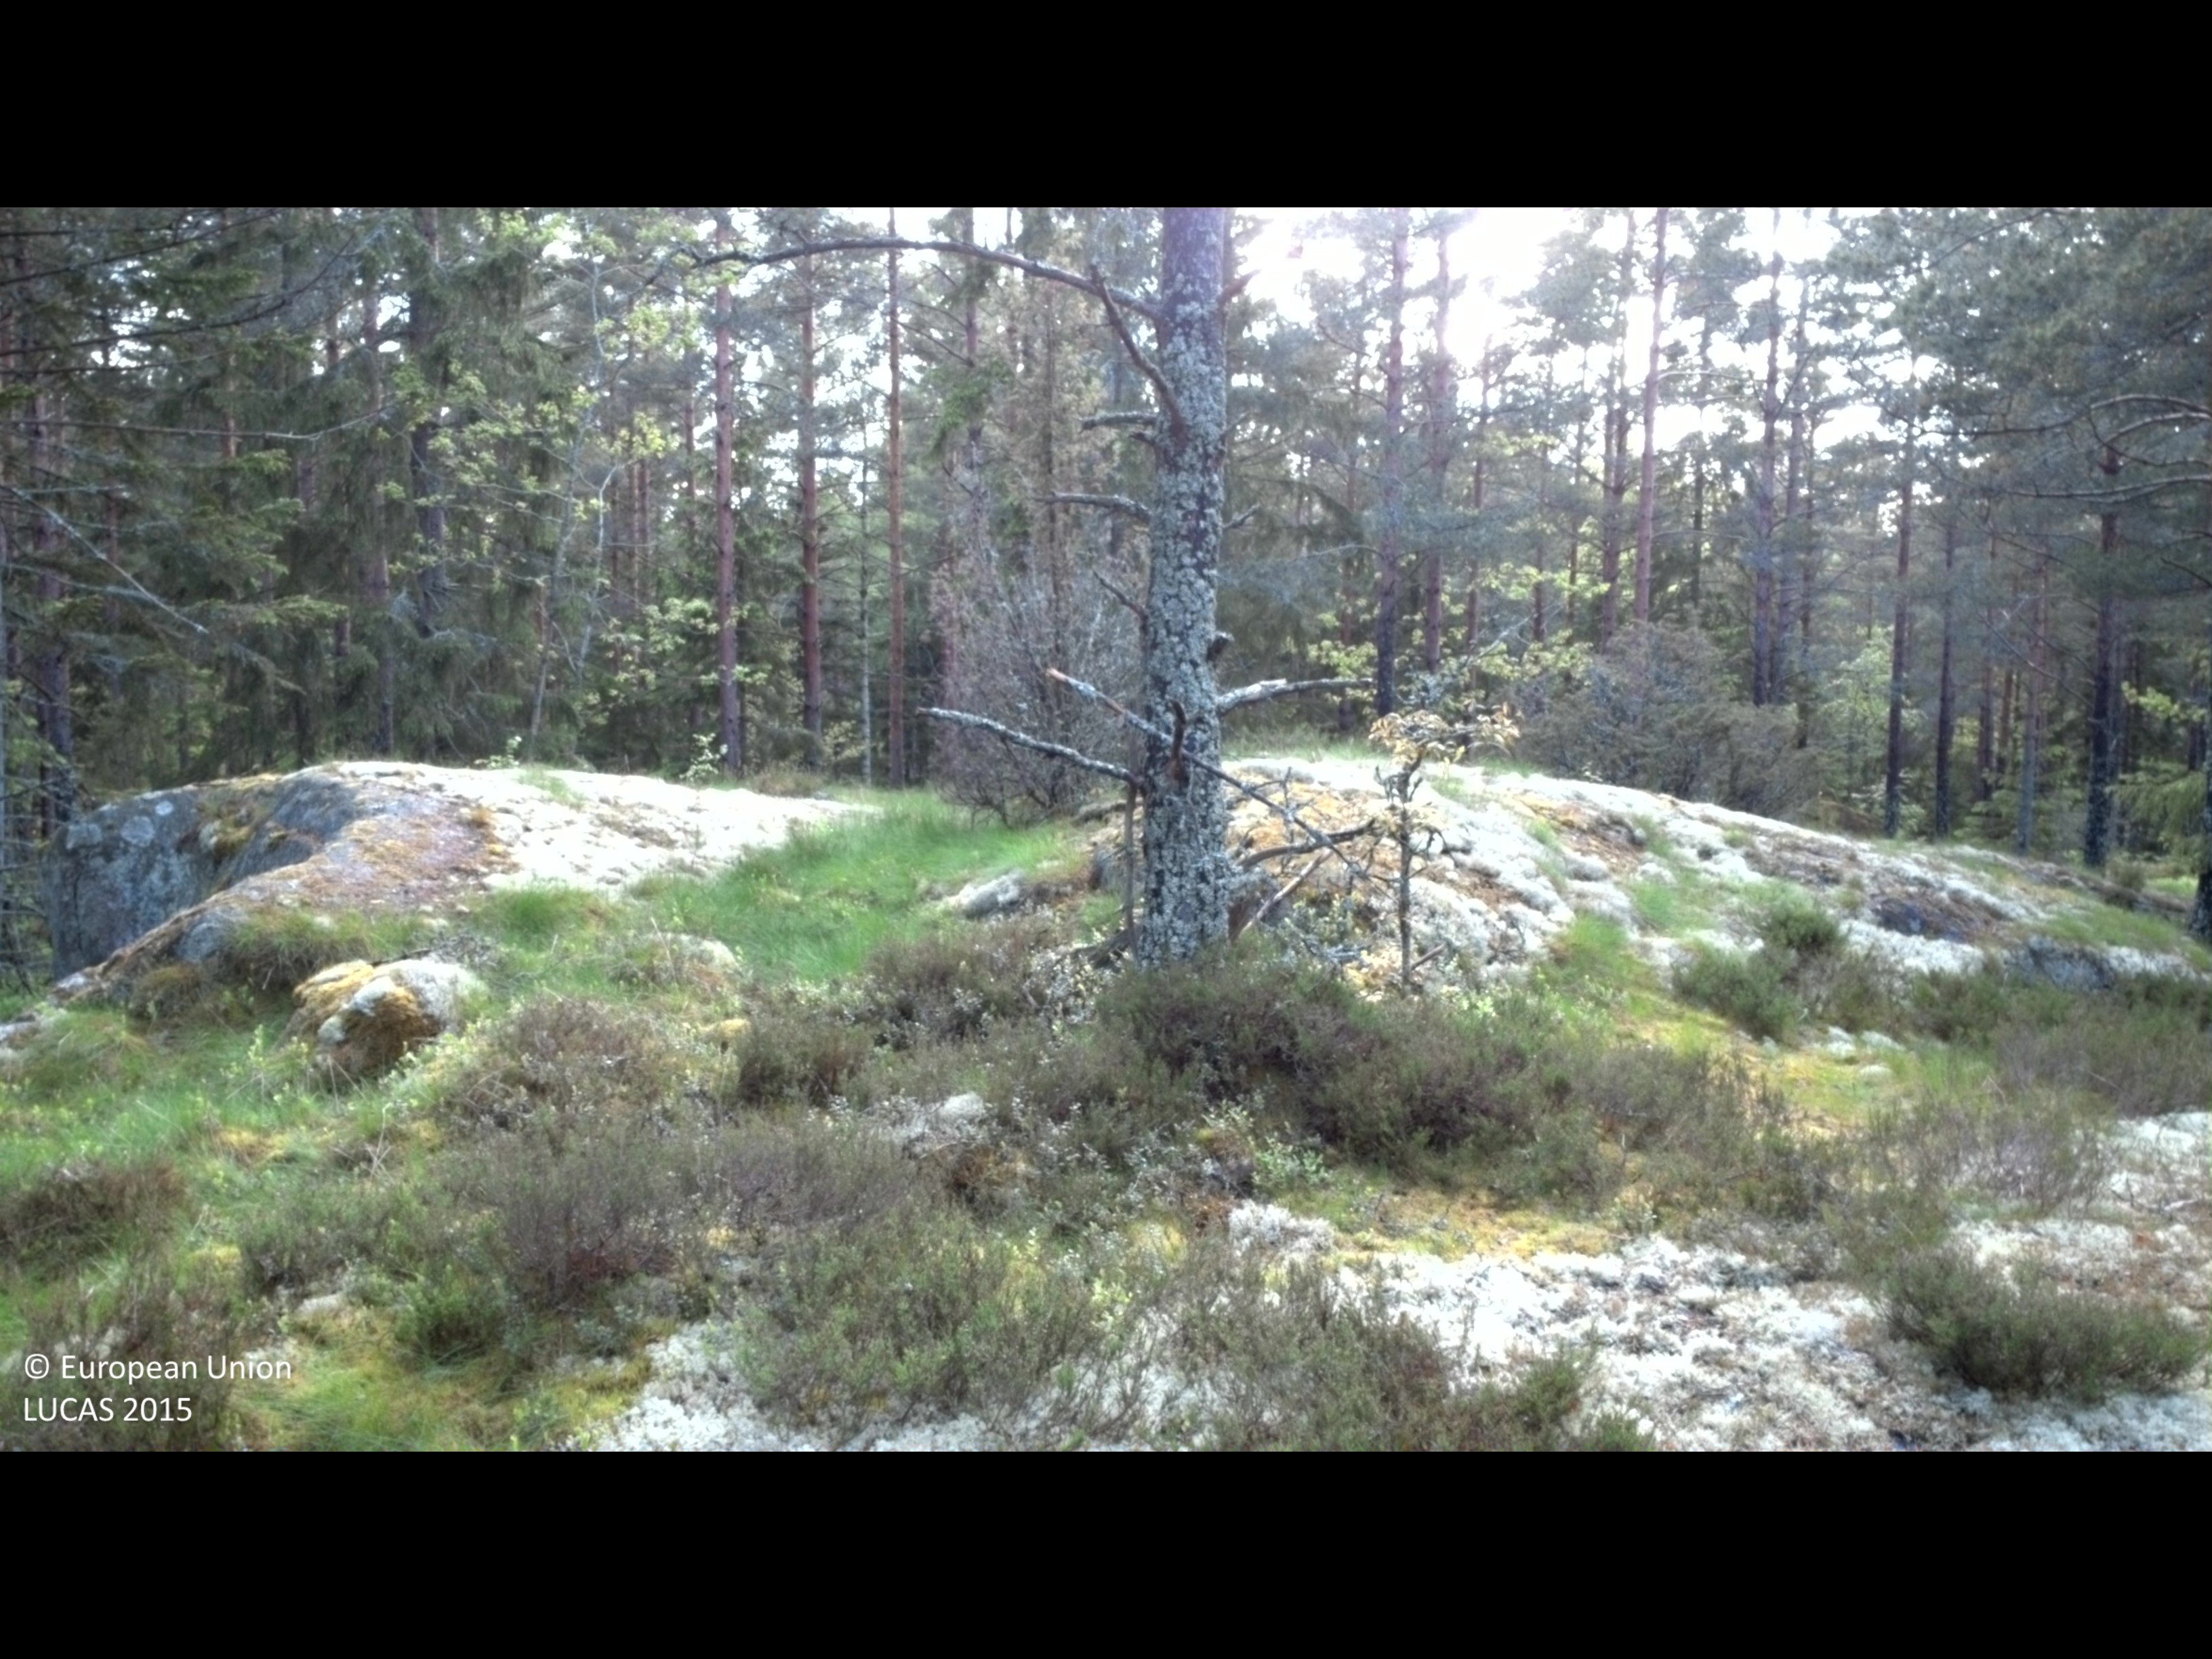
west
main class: Woodland
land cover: Pine dominated coniferous woodland
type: boreal forest
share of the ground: 25 - 50 %
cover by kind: coniferous forest trees 45 %, lichens and mosses 25 %, shrubs 15 %, broadleaved forest trees 5 %, herbaceous plants 5 %, consolidated bare surface 5 %
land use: Forestry
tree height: > 5 m
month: May
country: SE
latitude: 57.4299
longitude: 16.5116
